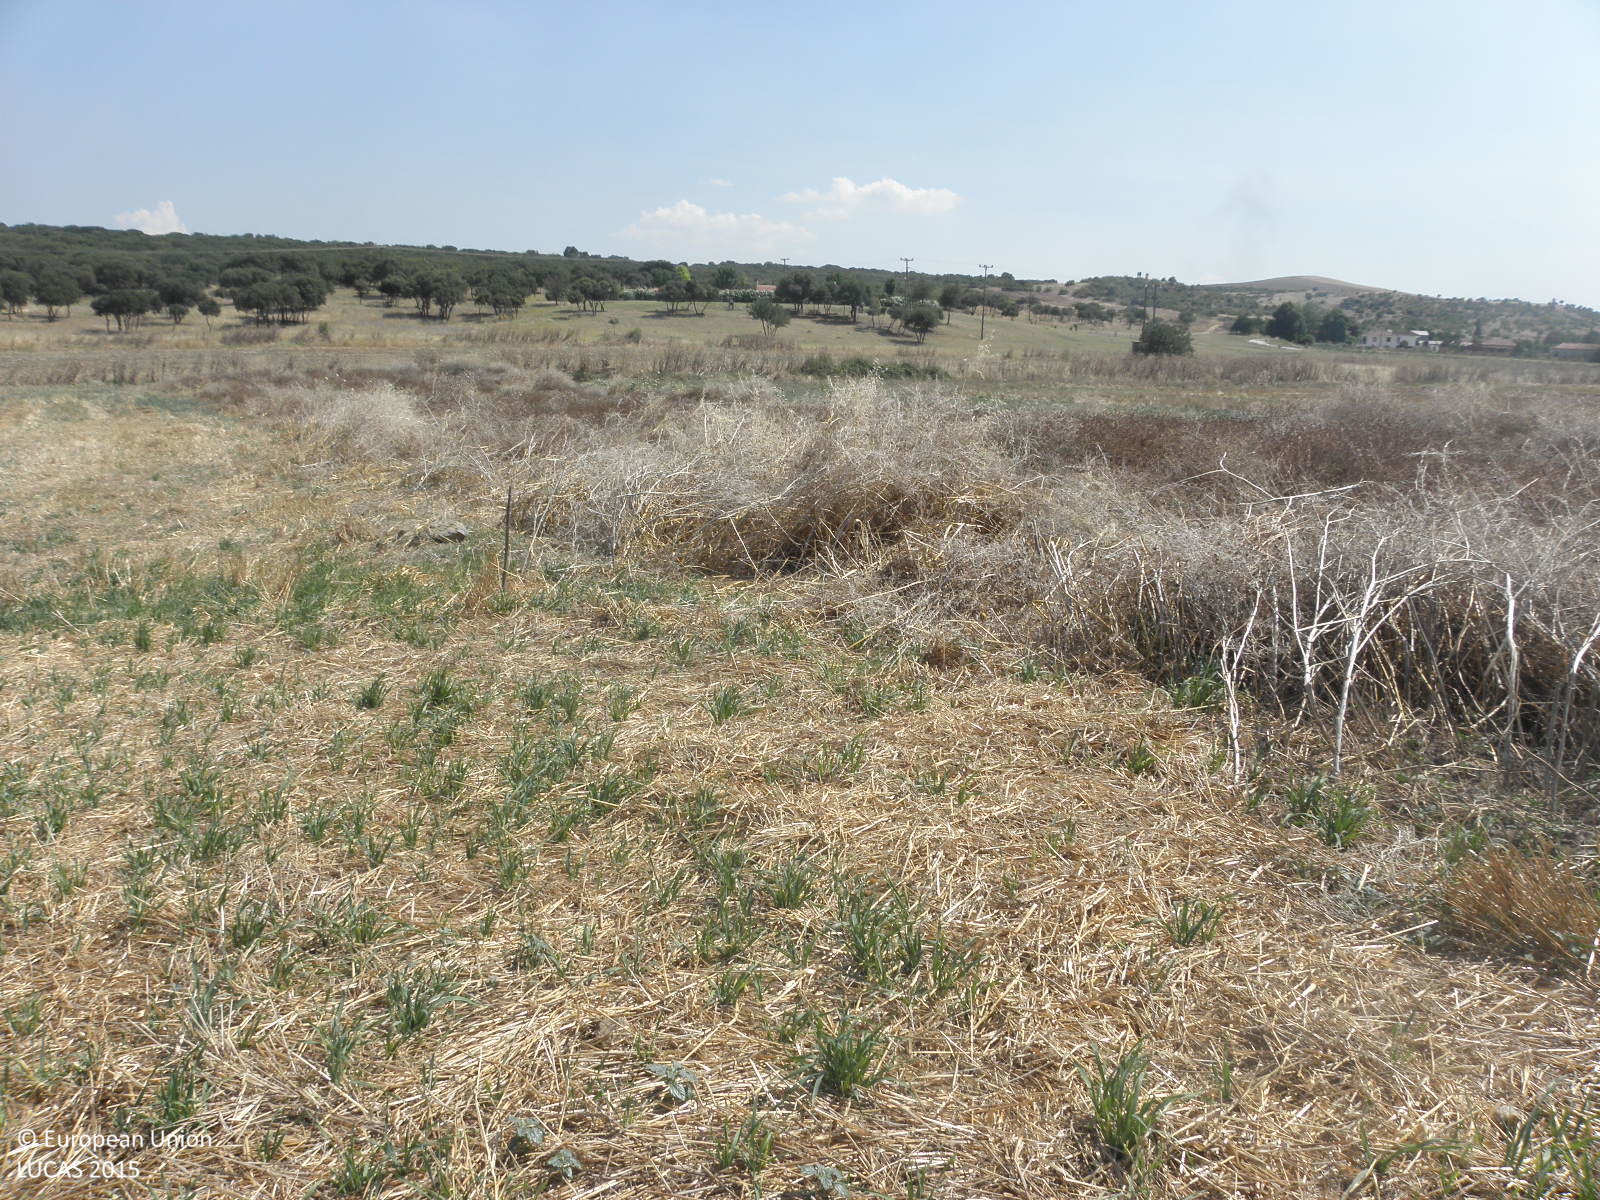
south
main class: Cropland
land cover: Durum wheat
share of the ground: > 75 %
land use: Agriculture (excluding fallow land and kitchen gardens)
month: July
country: GR
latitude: 39.4457
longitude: 22.3621
